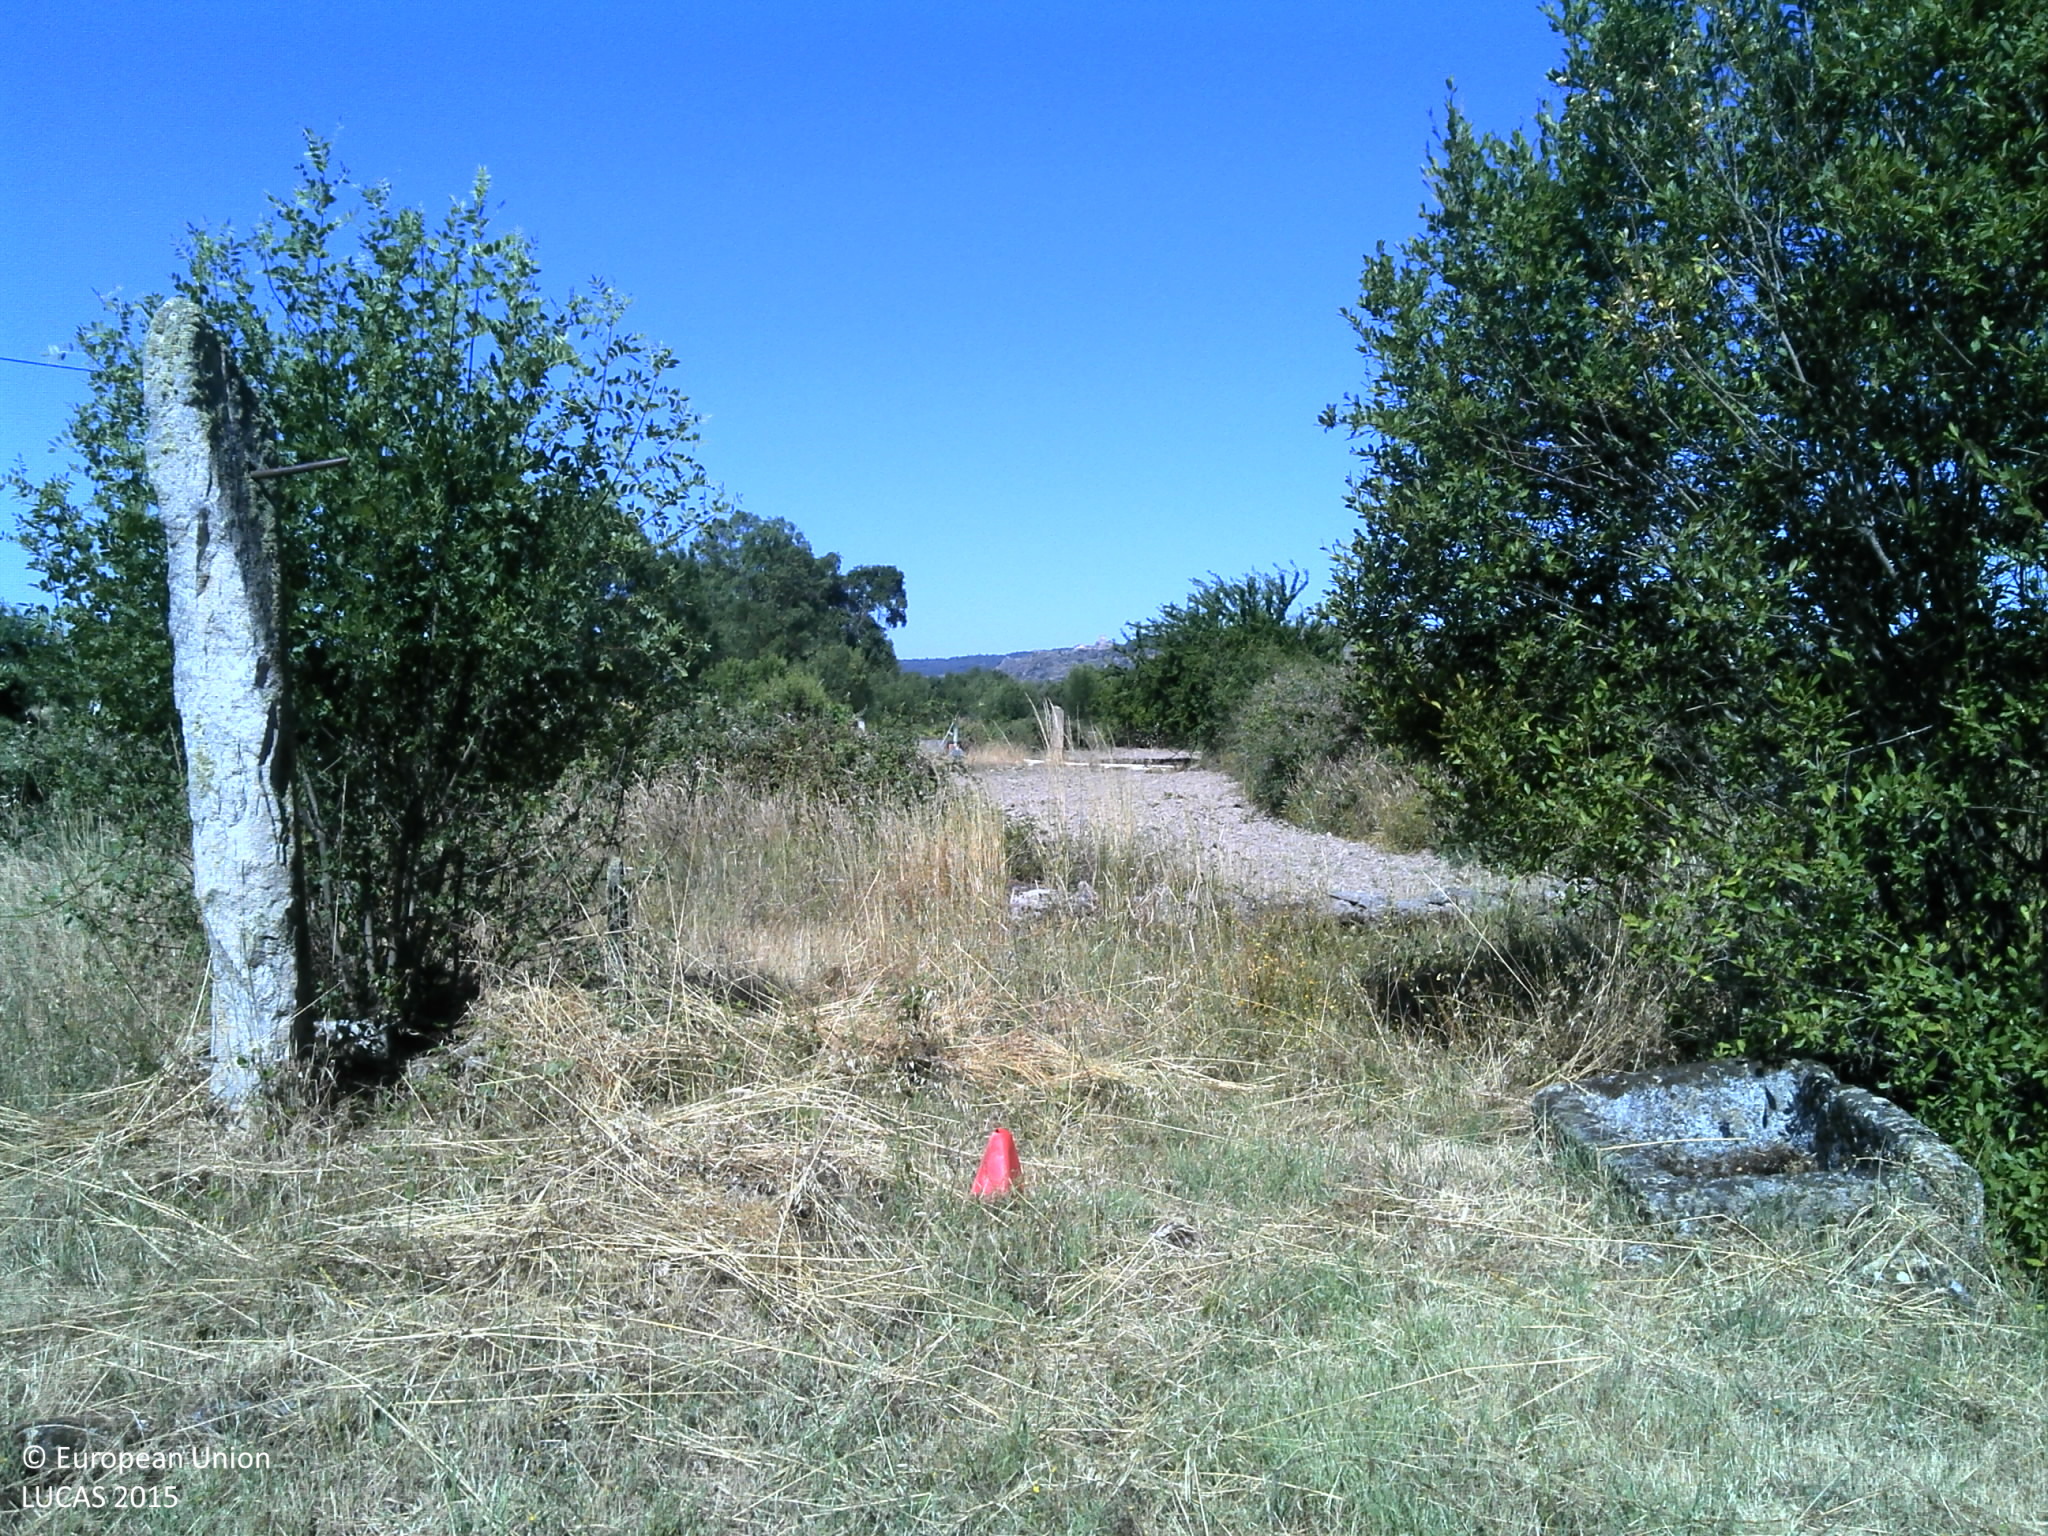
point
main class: Grassland
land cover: Grassland without tree/shrub cover
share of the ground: 50 - 75 %
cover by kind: herbaceous plants 65 %, unconsolidated bare surface 35 %
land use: Agriculture (excluding fallow land and kitchen gardens)
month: June
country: PT
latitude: 40.9124
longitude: -7.1951
